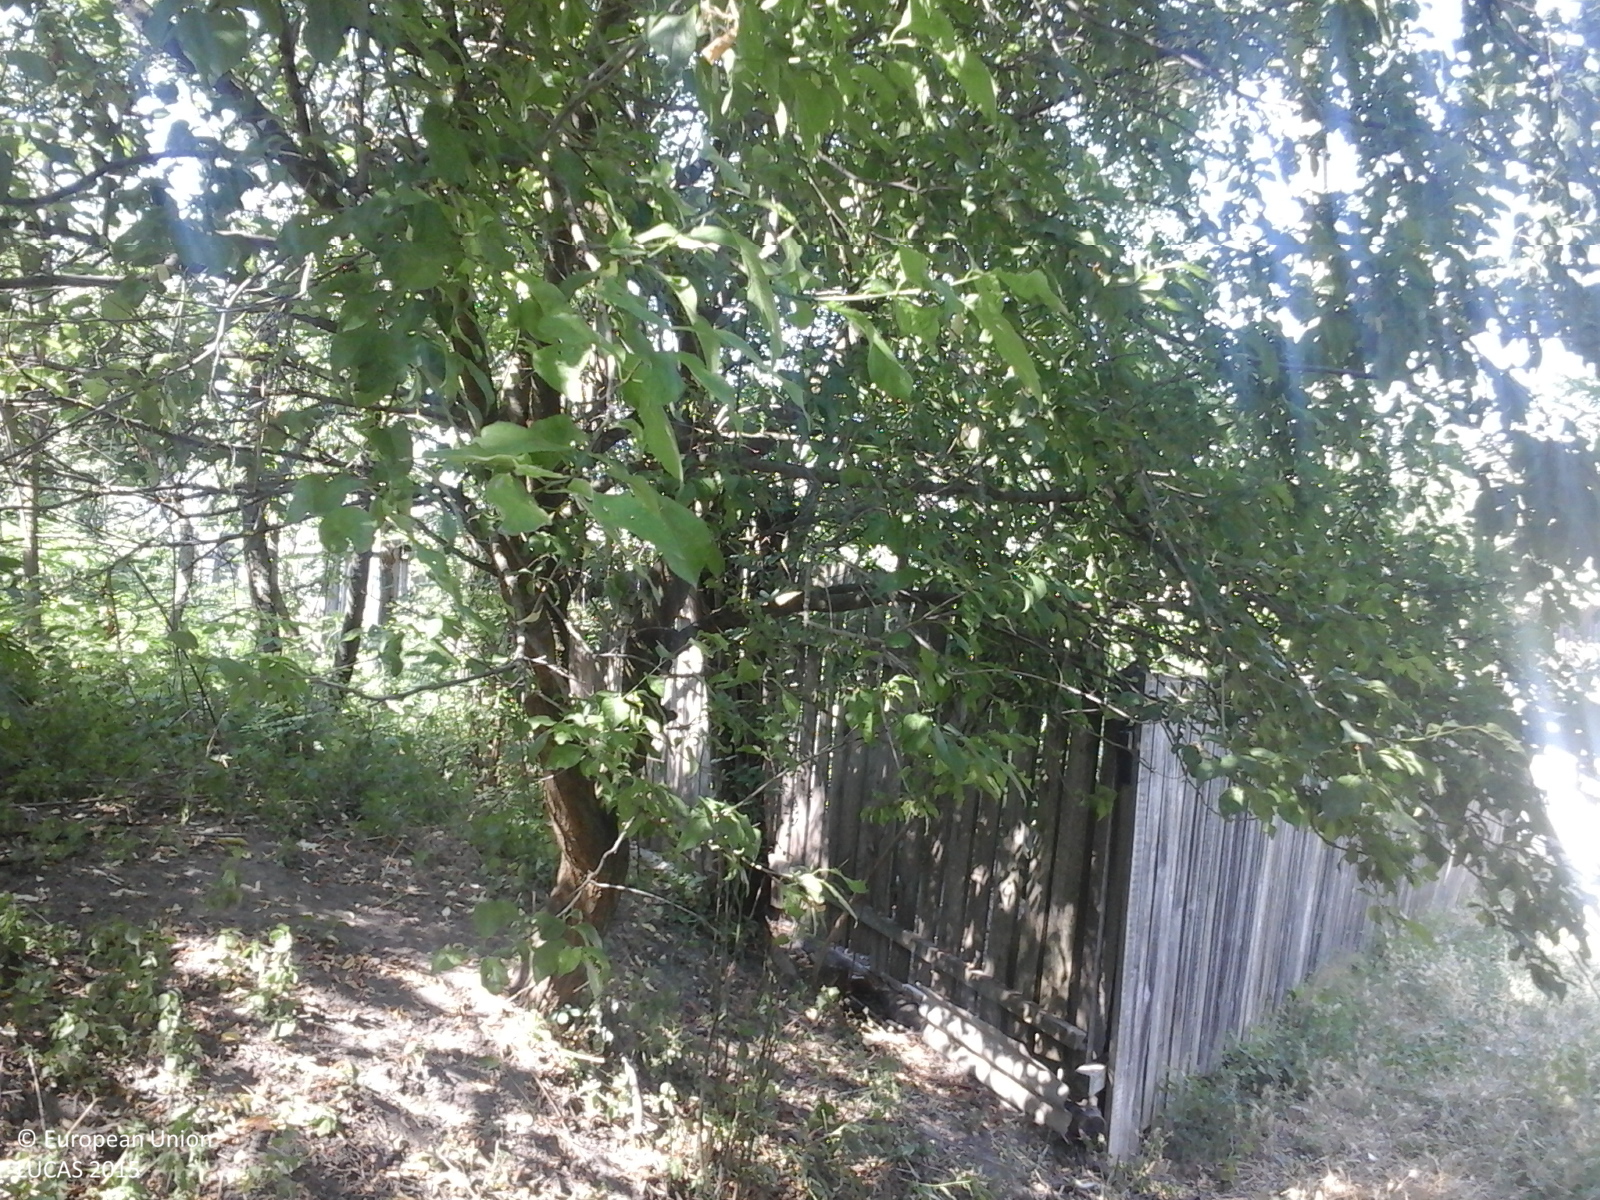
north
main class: Cropland
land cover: Other fruit trees and berries
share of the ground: 50 - 75 %
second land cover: Grassland without tree/shrub cover
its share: 10 - 25 %
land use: Agriculture (excluding fallow land and kitchen gardens)
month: July
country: RO
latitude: 46.3284
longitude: 27.2881
